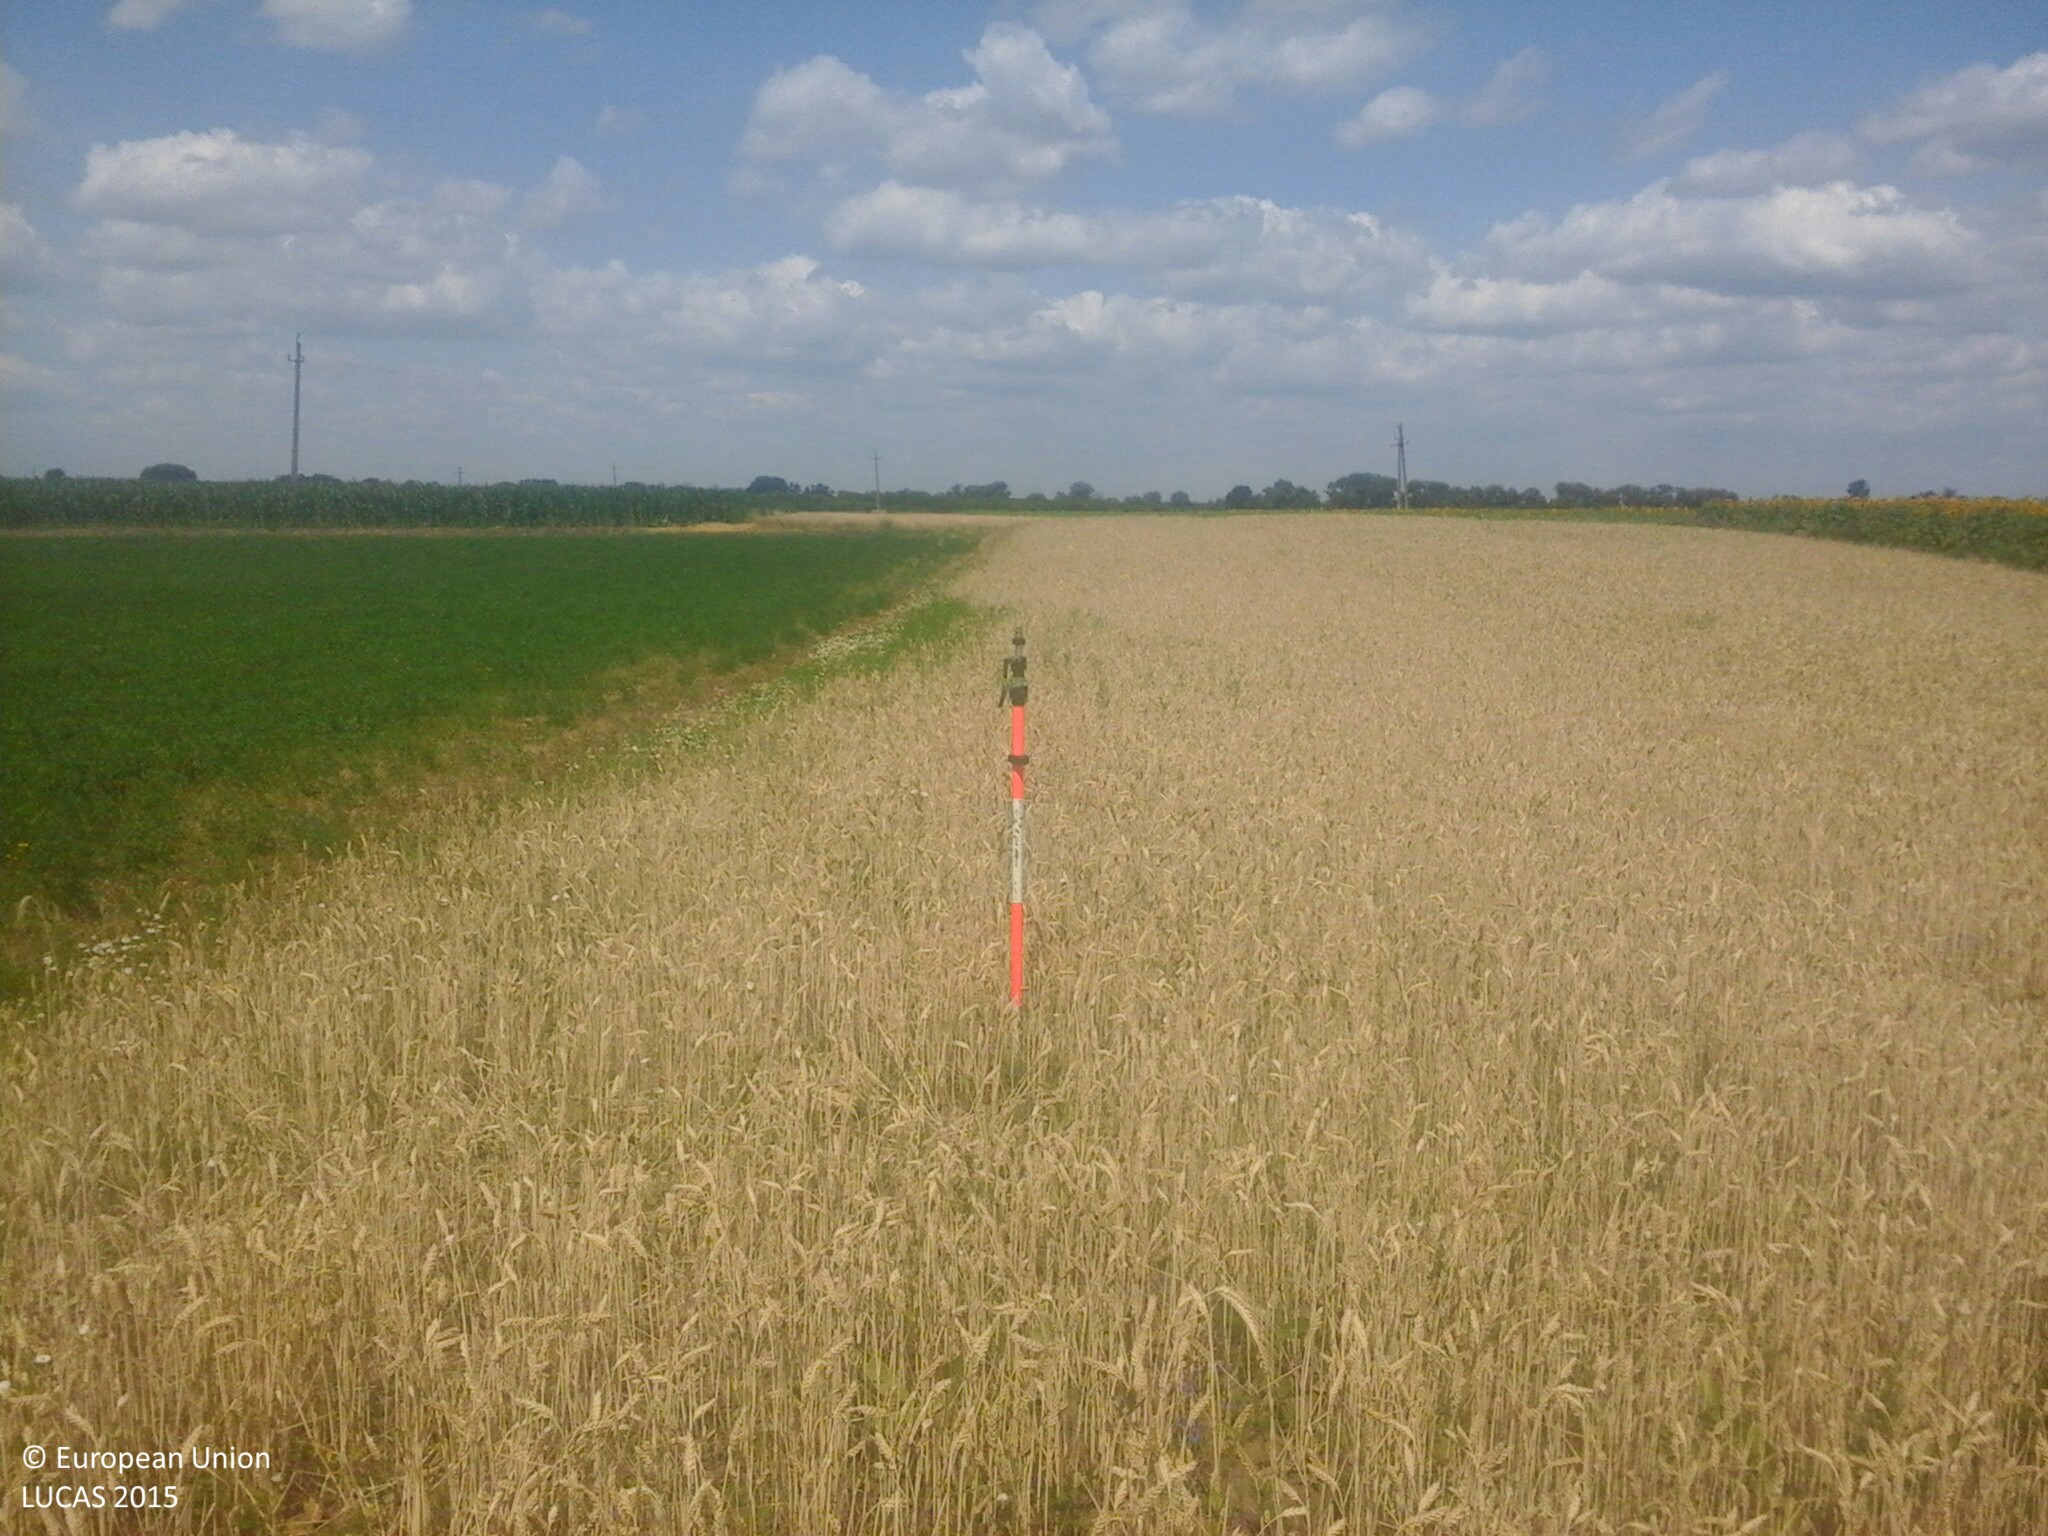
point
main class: Cropland
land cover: Triticale
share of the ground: > 75 %
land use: Agriculture (excluding fallow land and kitchen gardens)
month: July
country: HU
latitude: 48.0527
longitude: 22.3603
